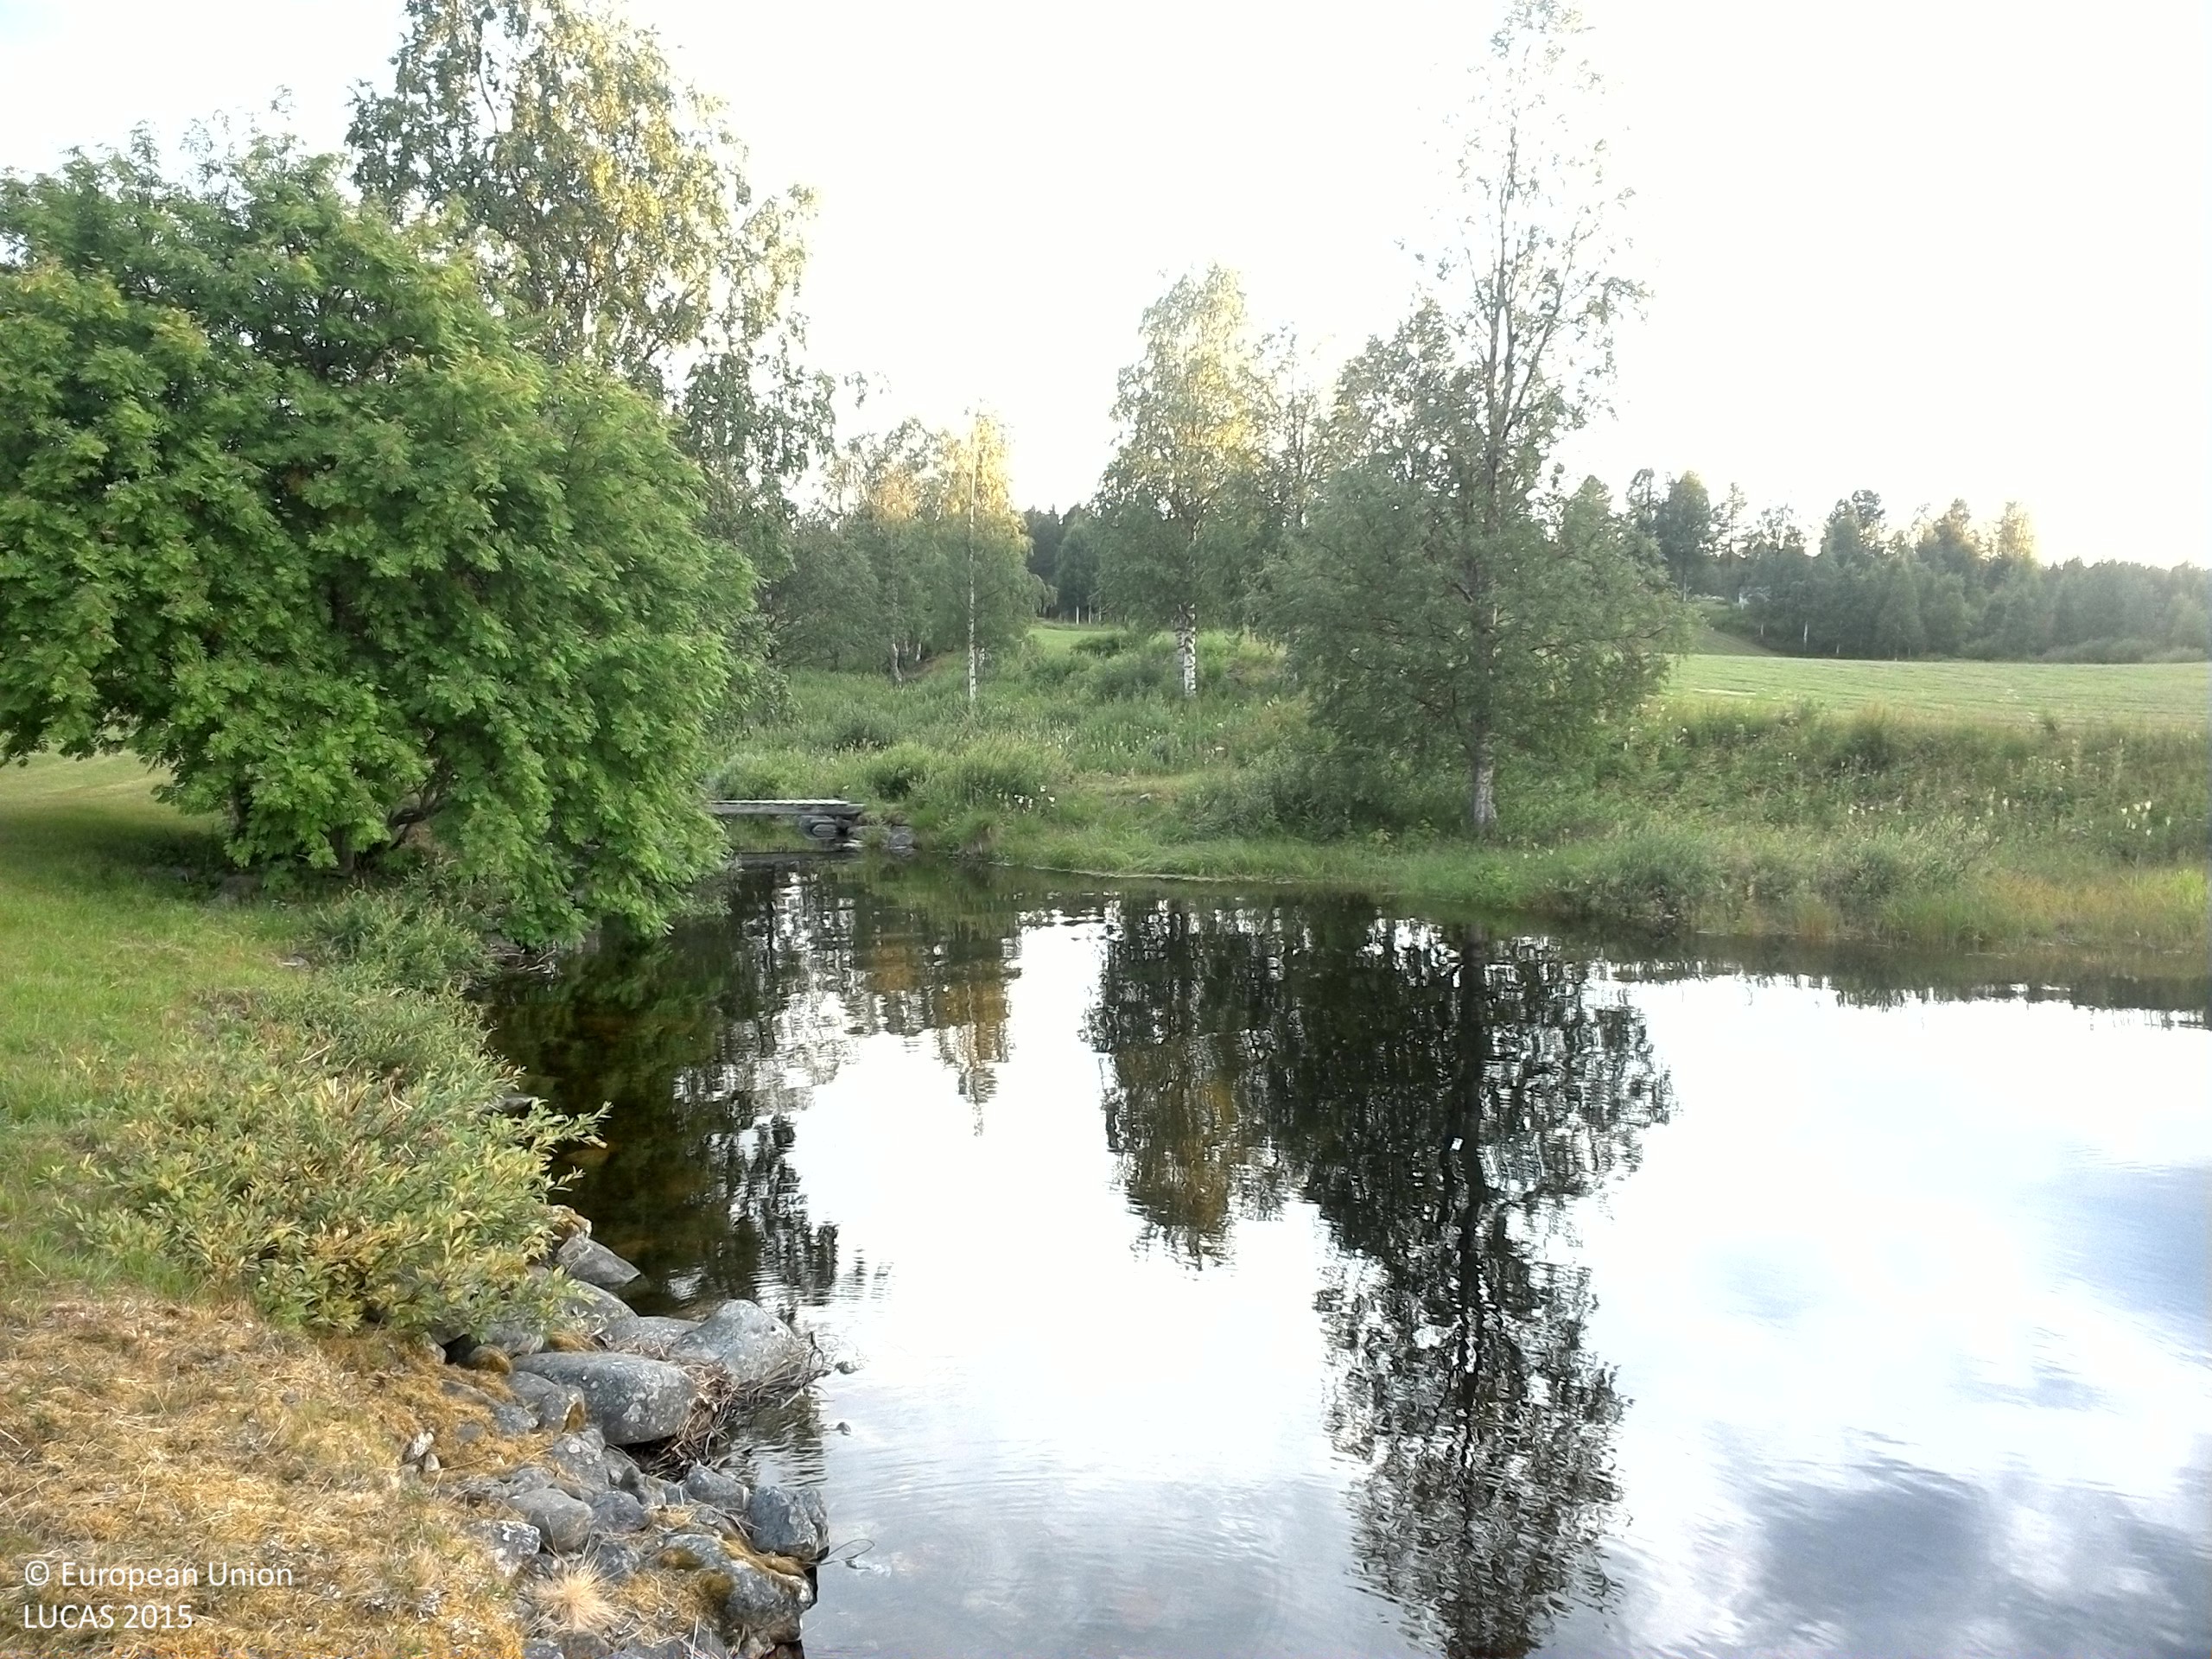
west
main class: Grassland
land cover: Grassland without tree/shrub cover
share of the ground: > 75 %
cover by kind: herbaceous plants 100 %
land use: Residential
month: July
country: SE
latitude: 64.3932
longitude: 16.0040
